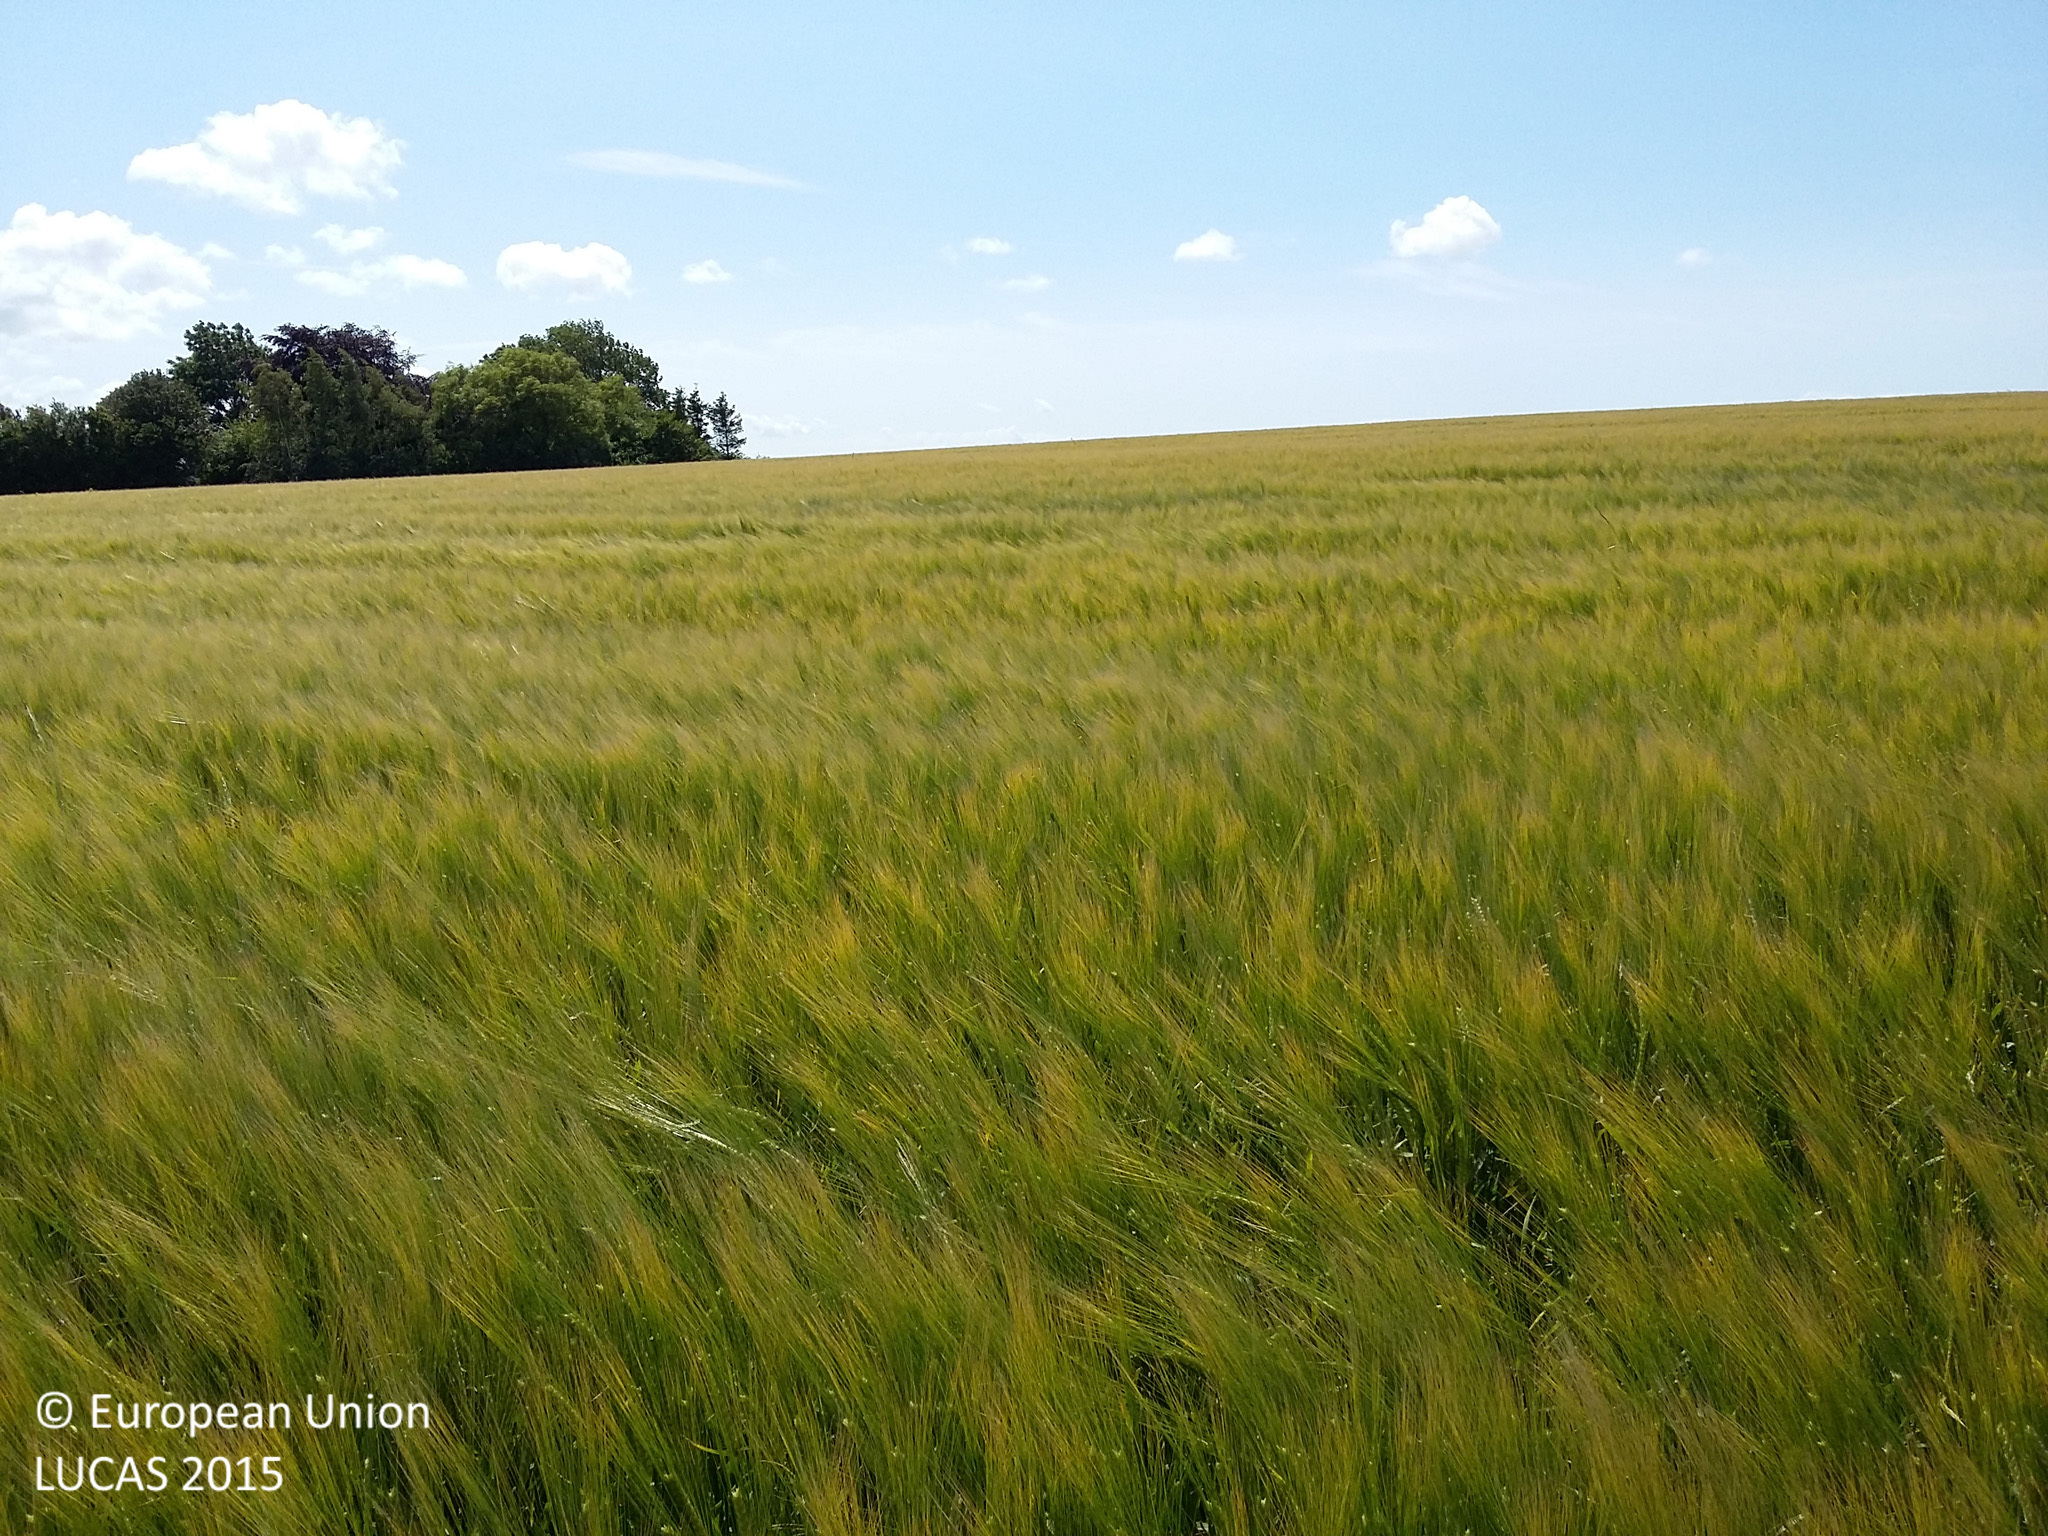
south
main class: Cropland
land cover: Barley
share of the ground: > 75 %
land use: Agriculture (excluding fallow land and kitchen gardens)
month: July
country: DK
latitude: 55.5884
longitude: 11.2523
